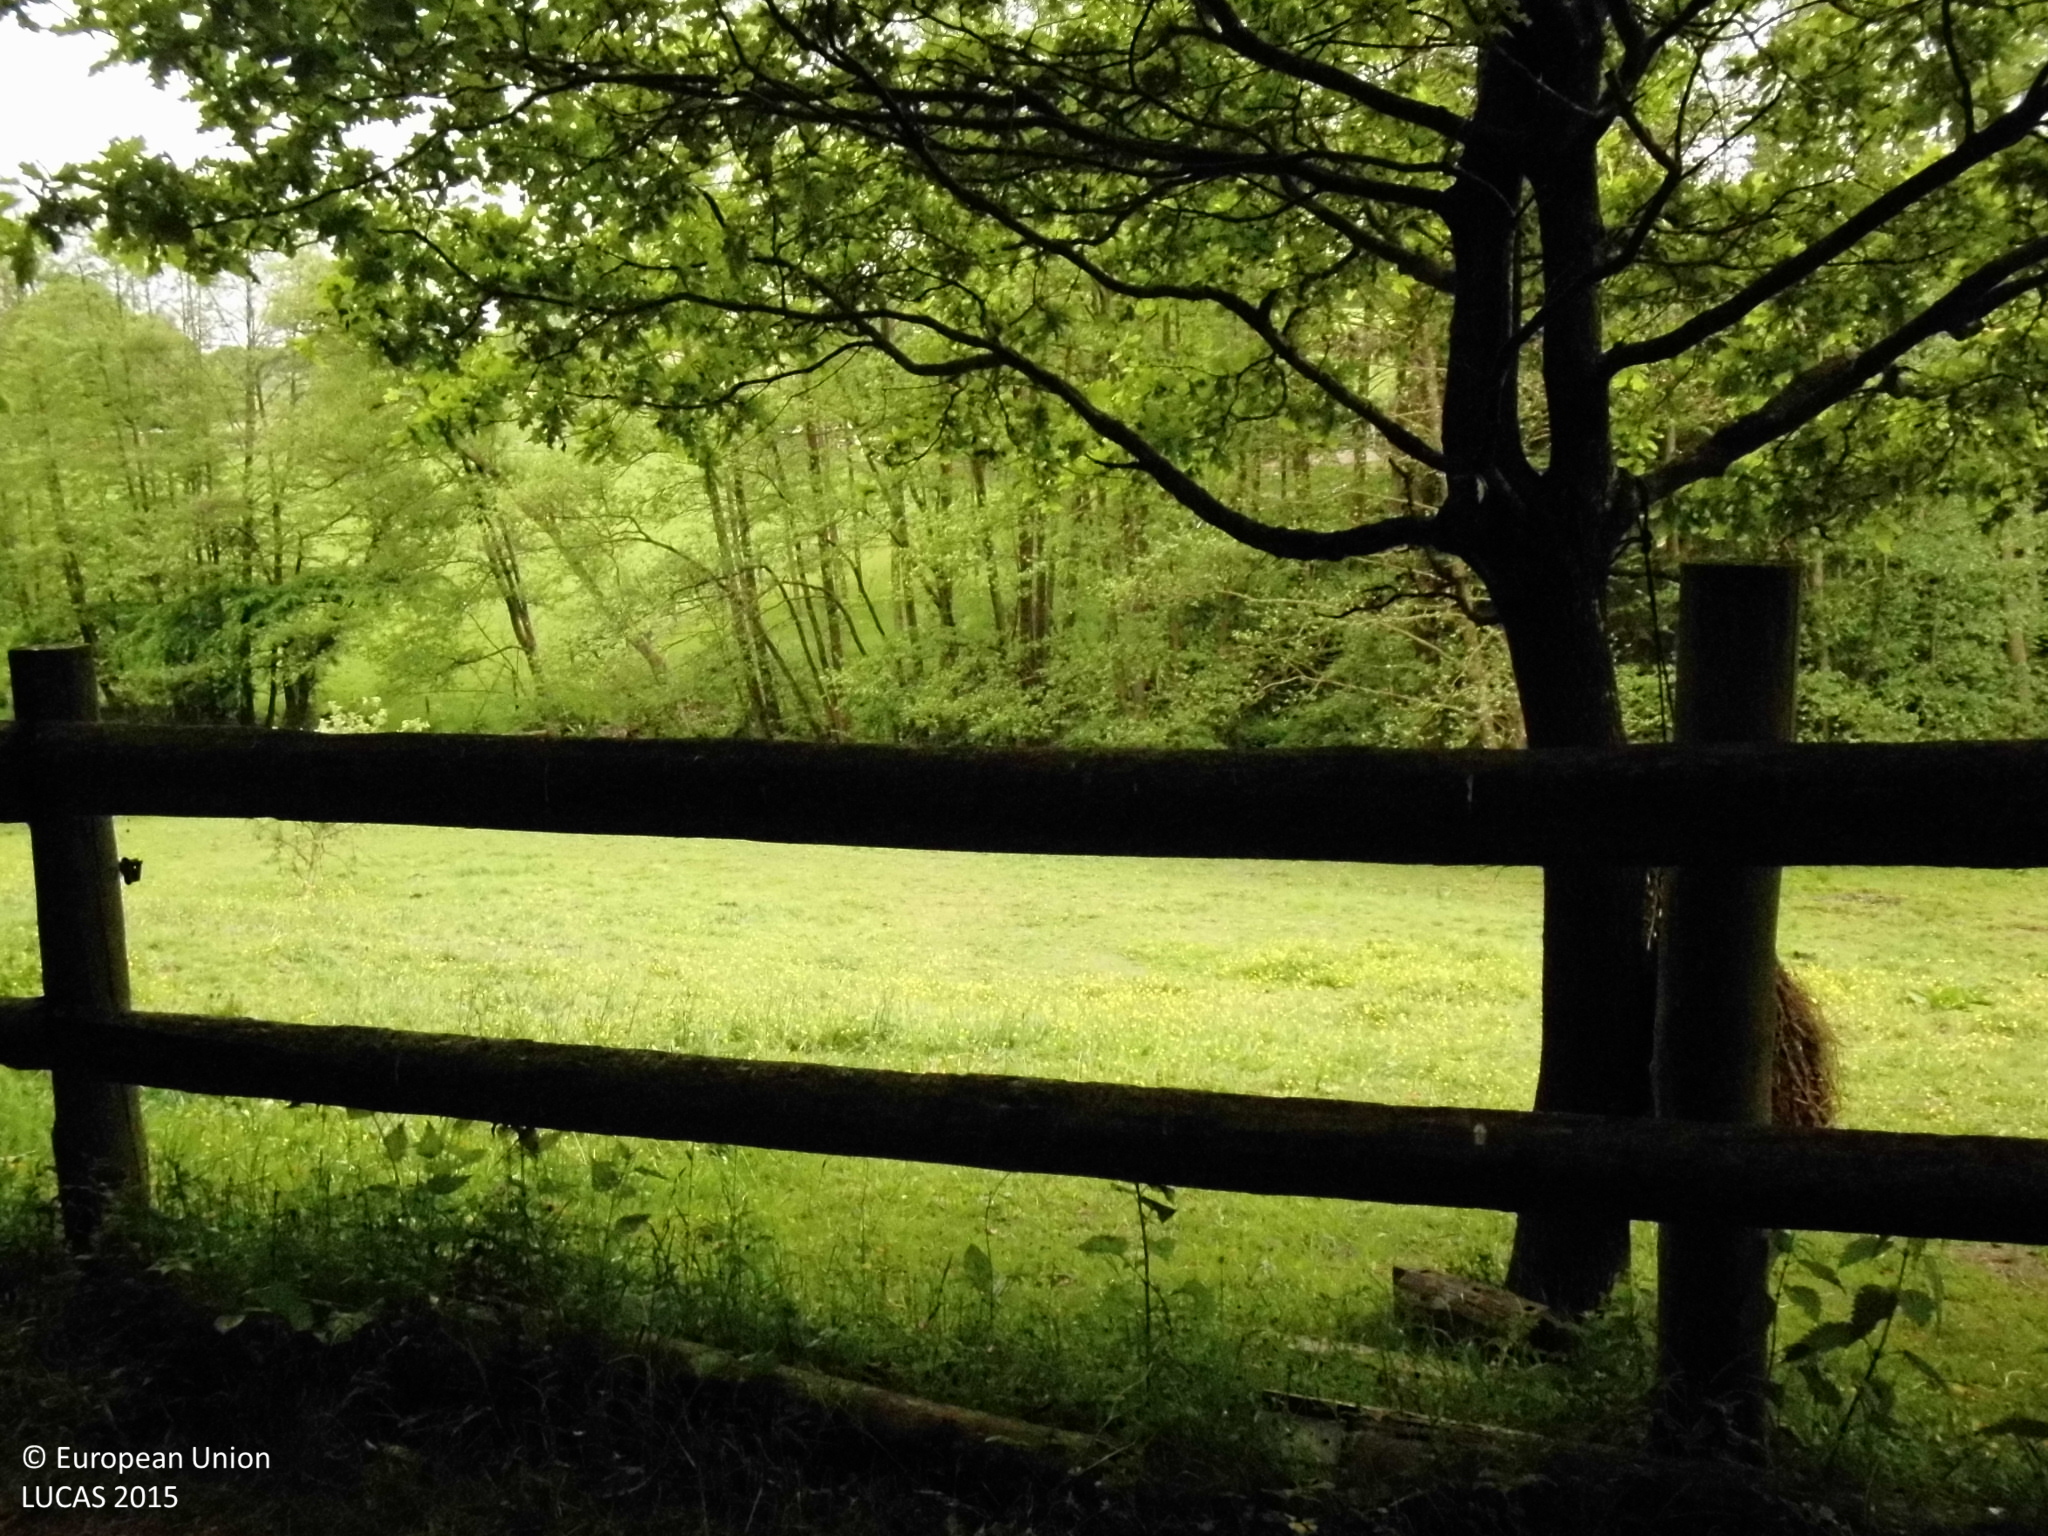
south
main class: Woodland
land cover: Broadleaved woodland
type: mesophytic deciduous forest
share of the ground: > 75 %
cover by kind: broadleaved forest trees 100 %
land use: Forestry
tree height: > 5 m
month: May
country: DE
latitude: 50.8761
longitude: 7.4847
